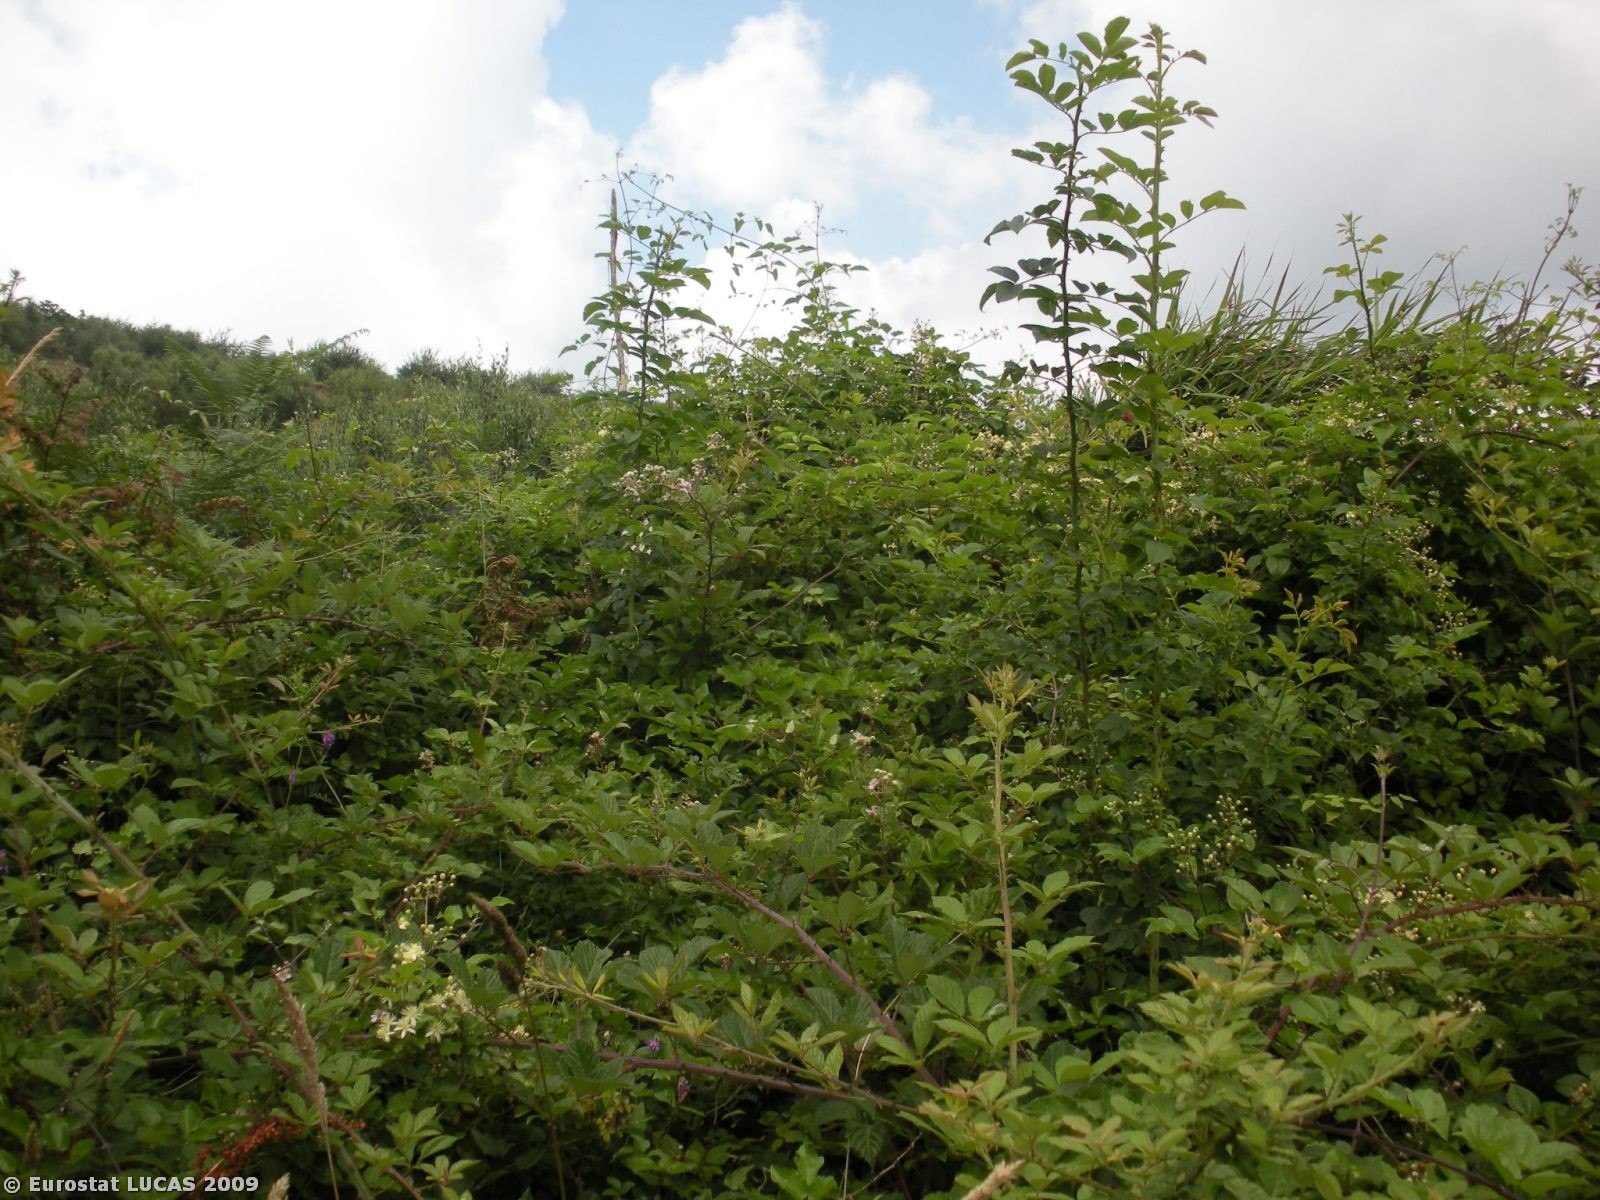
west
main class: Woodland
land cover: Broadleaved woodland
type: thermophilous deciduous forest
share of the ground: > 75 %
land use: Nature reserves
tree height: > 5 m
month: July
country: IT
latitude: 40.2644
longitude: 15.0456
